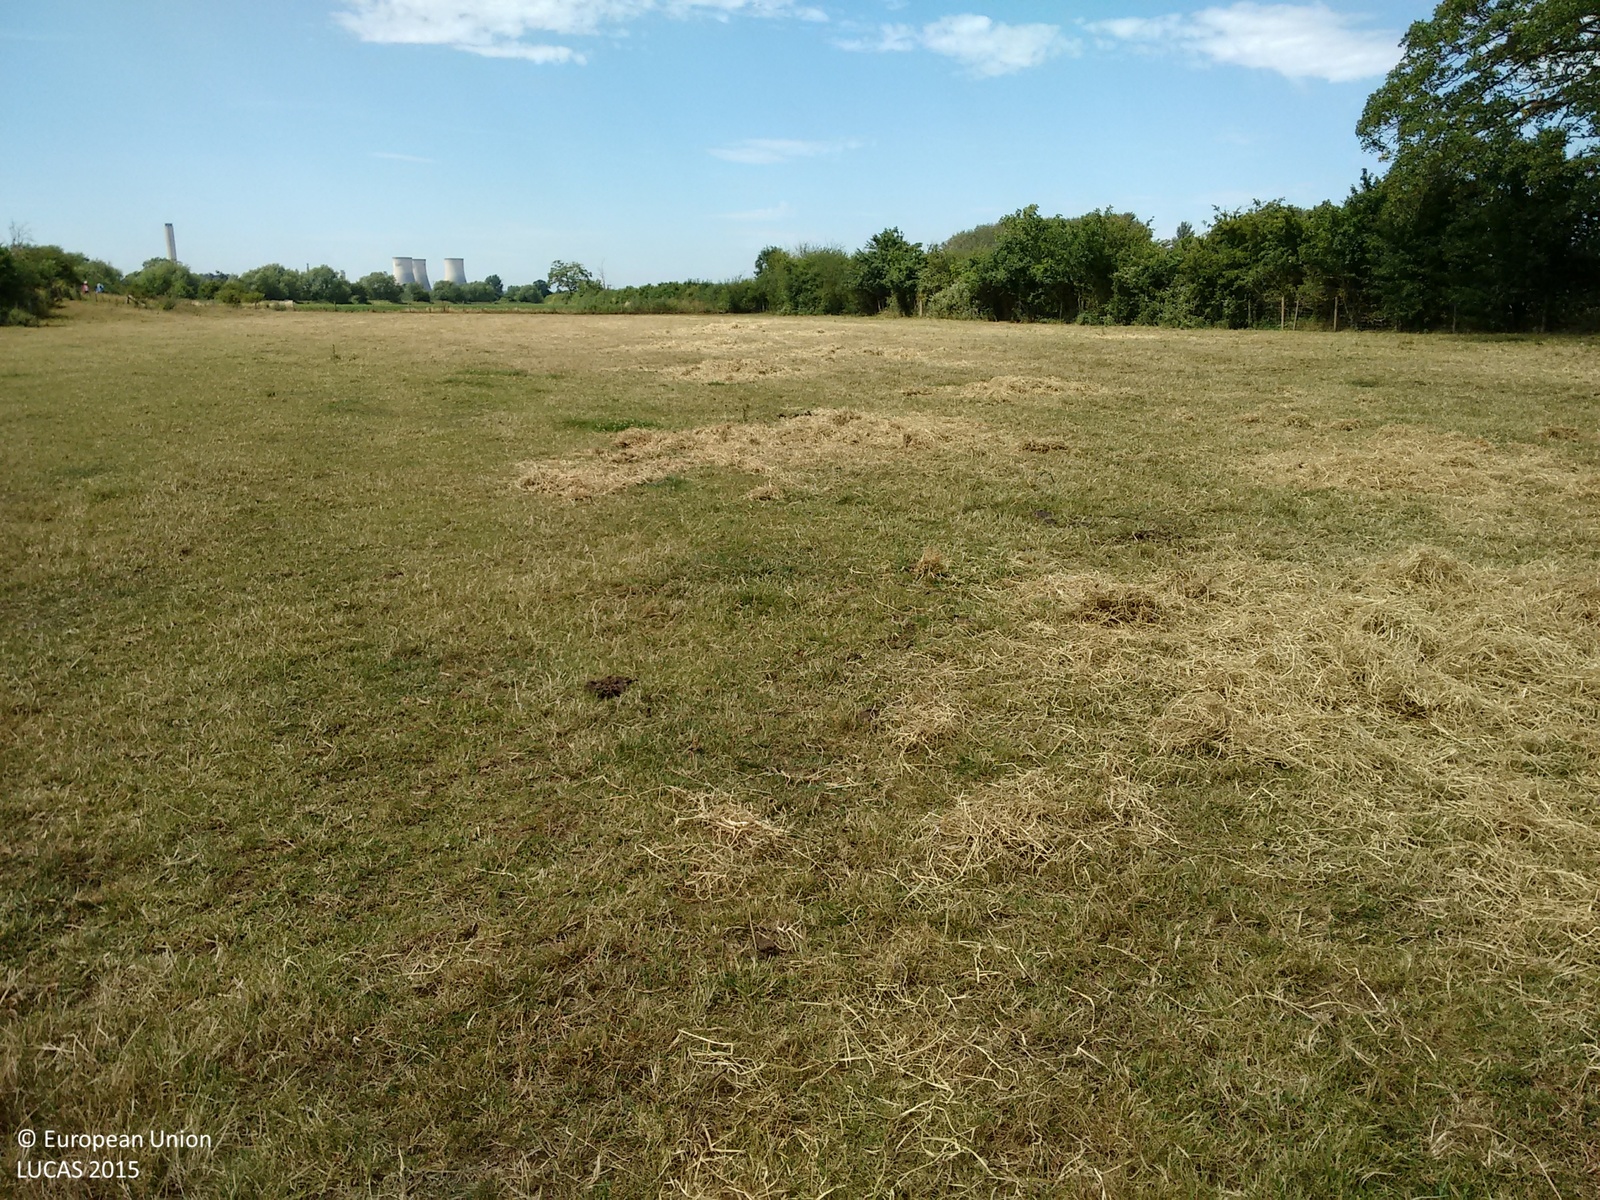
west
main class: Grassland
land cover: Grassland without tree/shrub cover
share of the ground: > 75 %
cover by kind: herbaceous plants 100 %
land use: Agriculture (excluding fallow land and kitchen gardens)
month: July
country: GB
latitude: 51.6441
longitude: -1.2181
